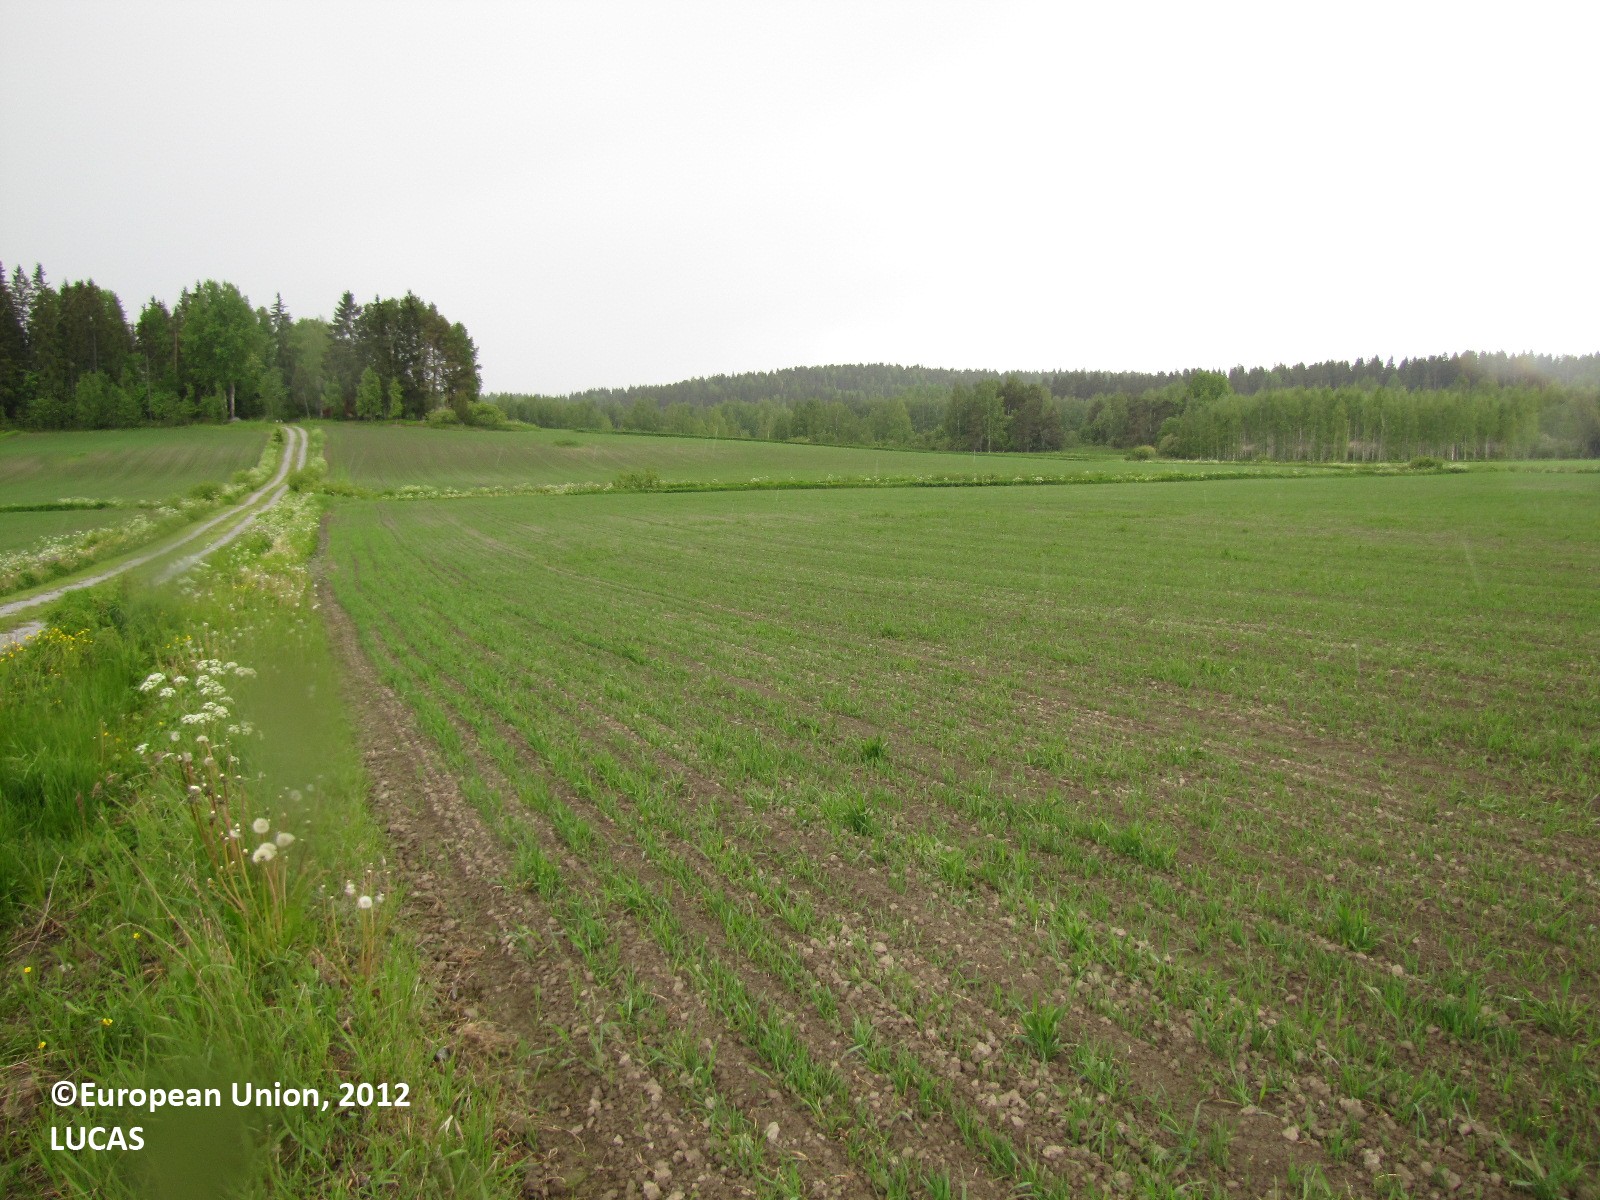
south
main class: Cropland
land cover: Common wheat
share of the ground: 25 - 50 %
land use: Agriculture (excluding fallow land and kitchen gardens)
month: June
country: FI
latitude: 61.2826
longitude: 23.5331
